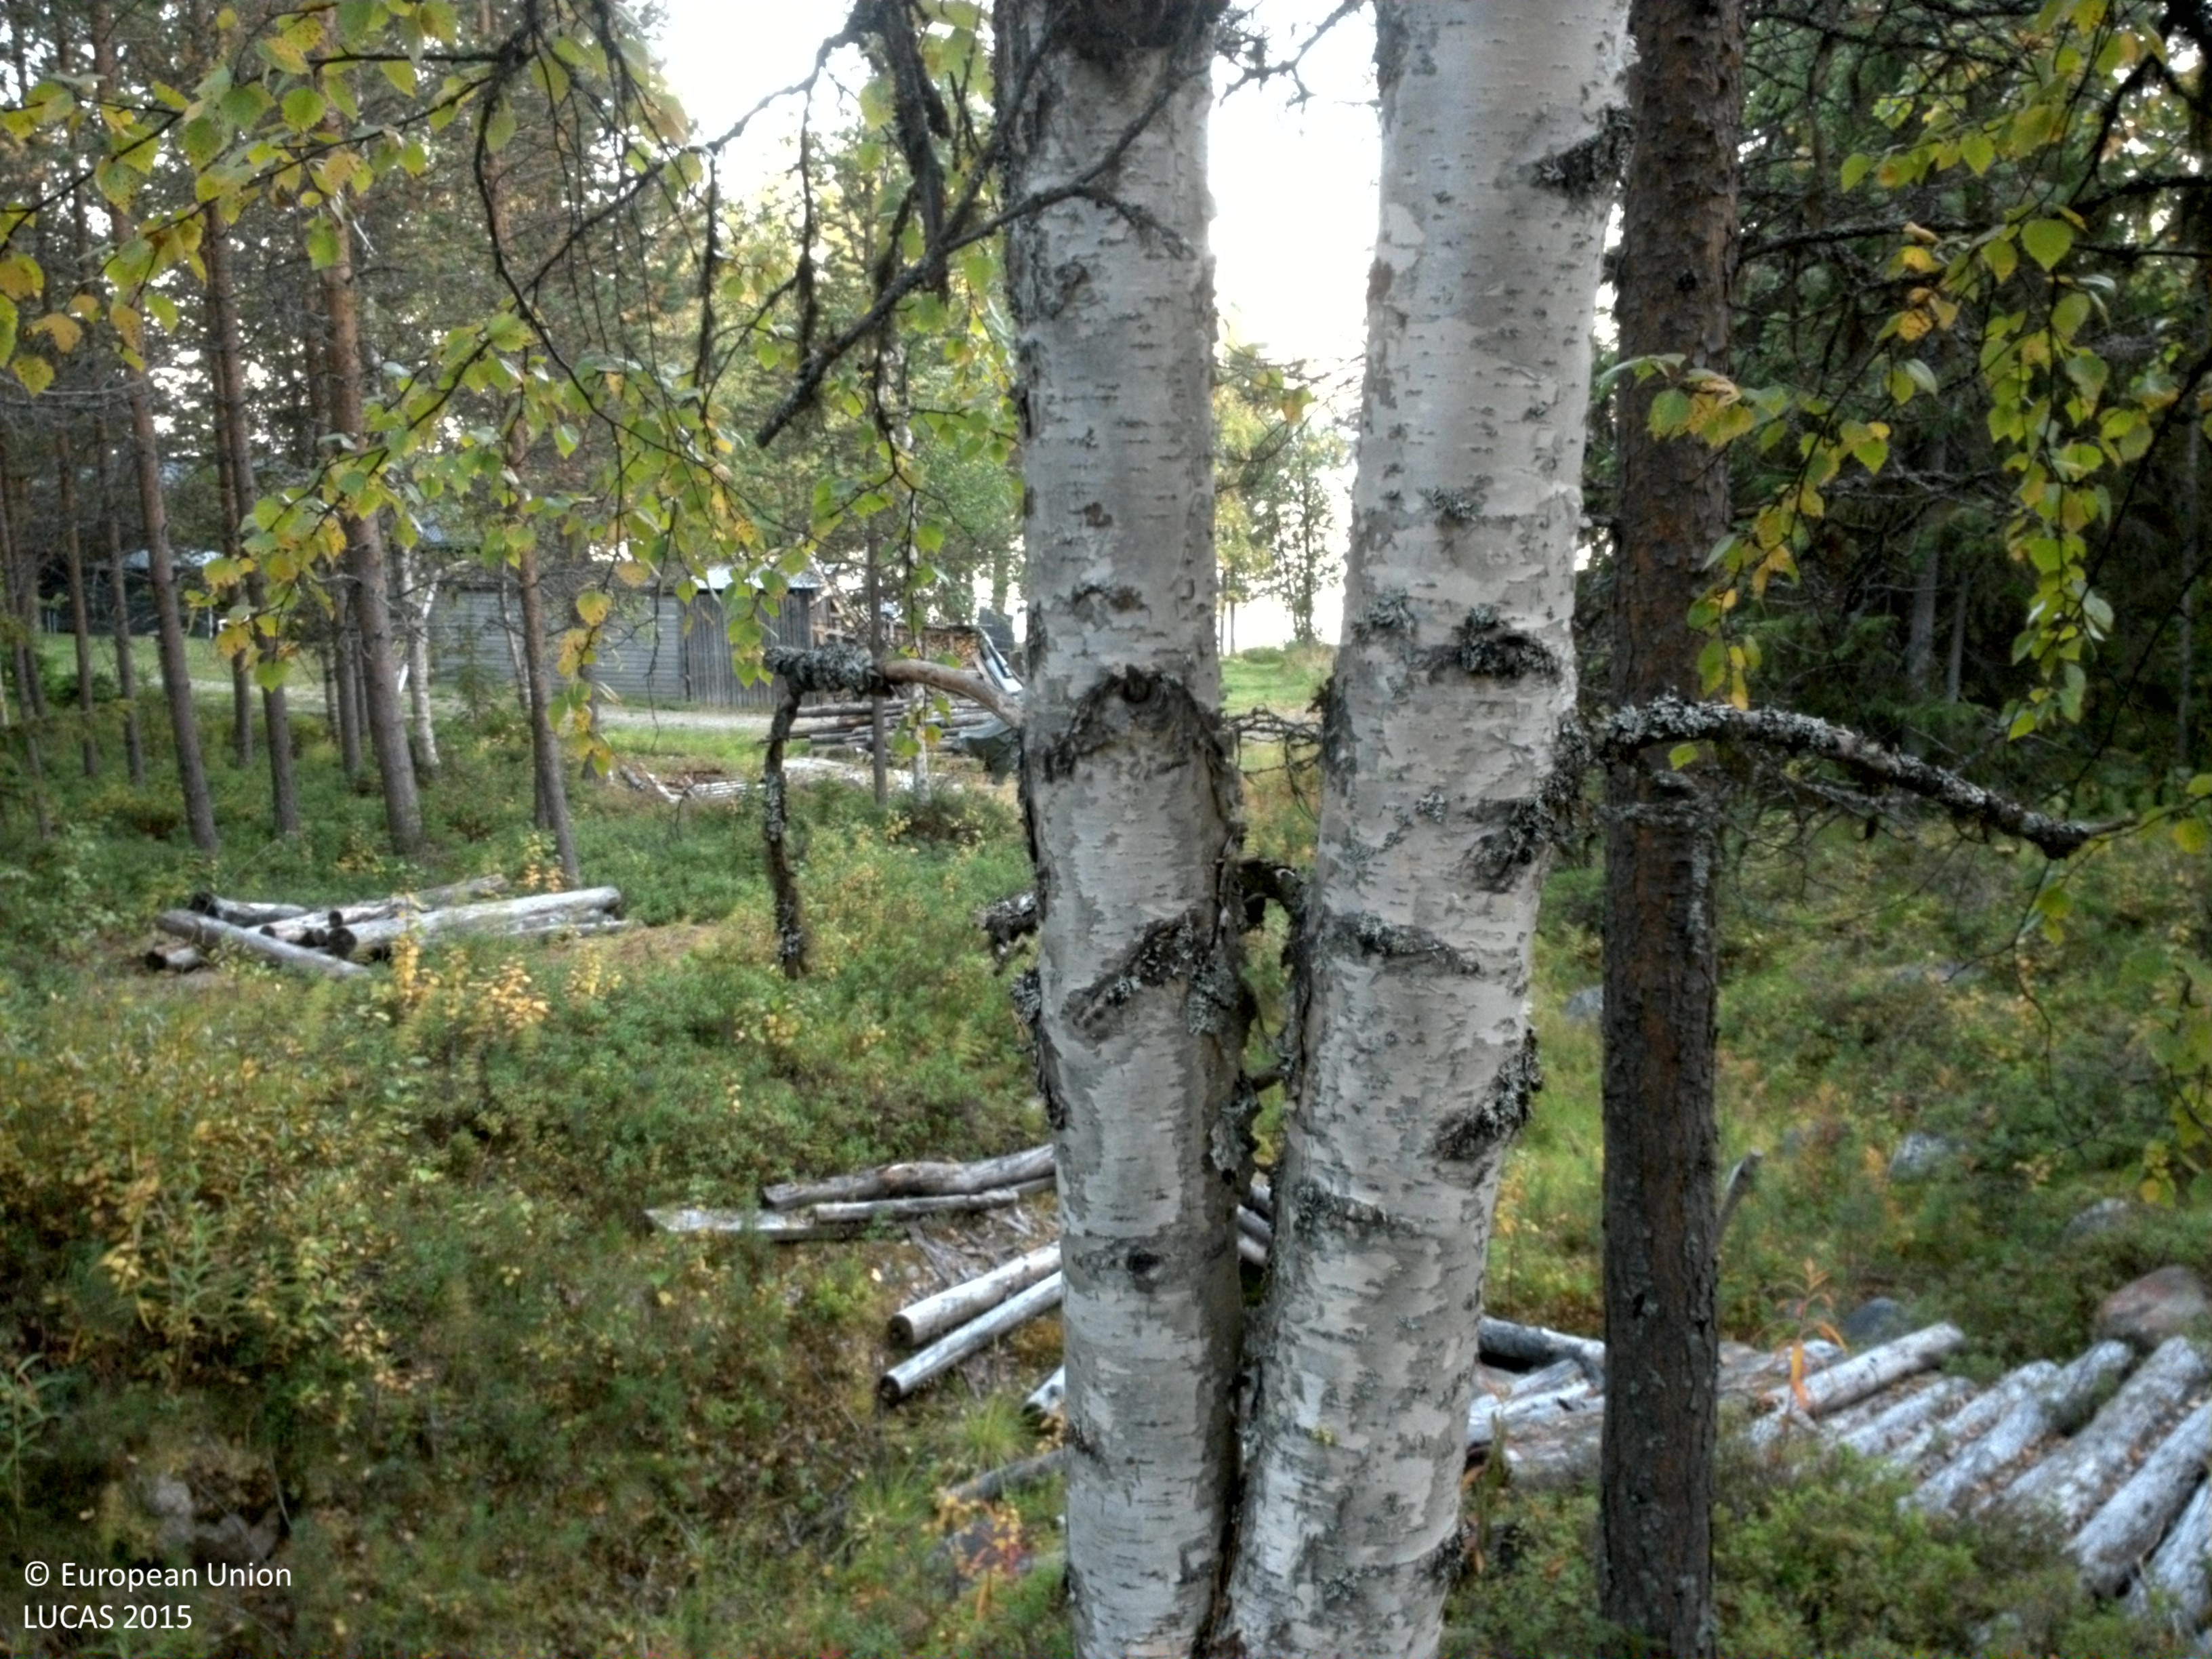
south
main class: Woodland
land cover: Pine dominated coniferous woodland
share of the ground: 25 - 50 %
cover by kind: shrubs 40 %, coniferous forest trees 30 %, herbaceous plants 20 %, broadleaved forest trees 5 %, lichens and mosses 5 %
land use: Forestry
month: September
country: SE
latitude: 65.2684
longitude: 16.7959
